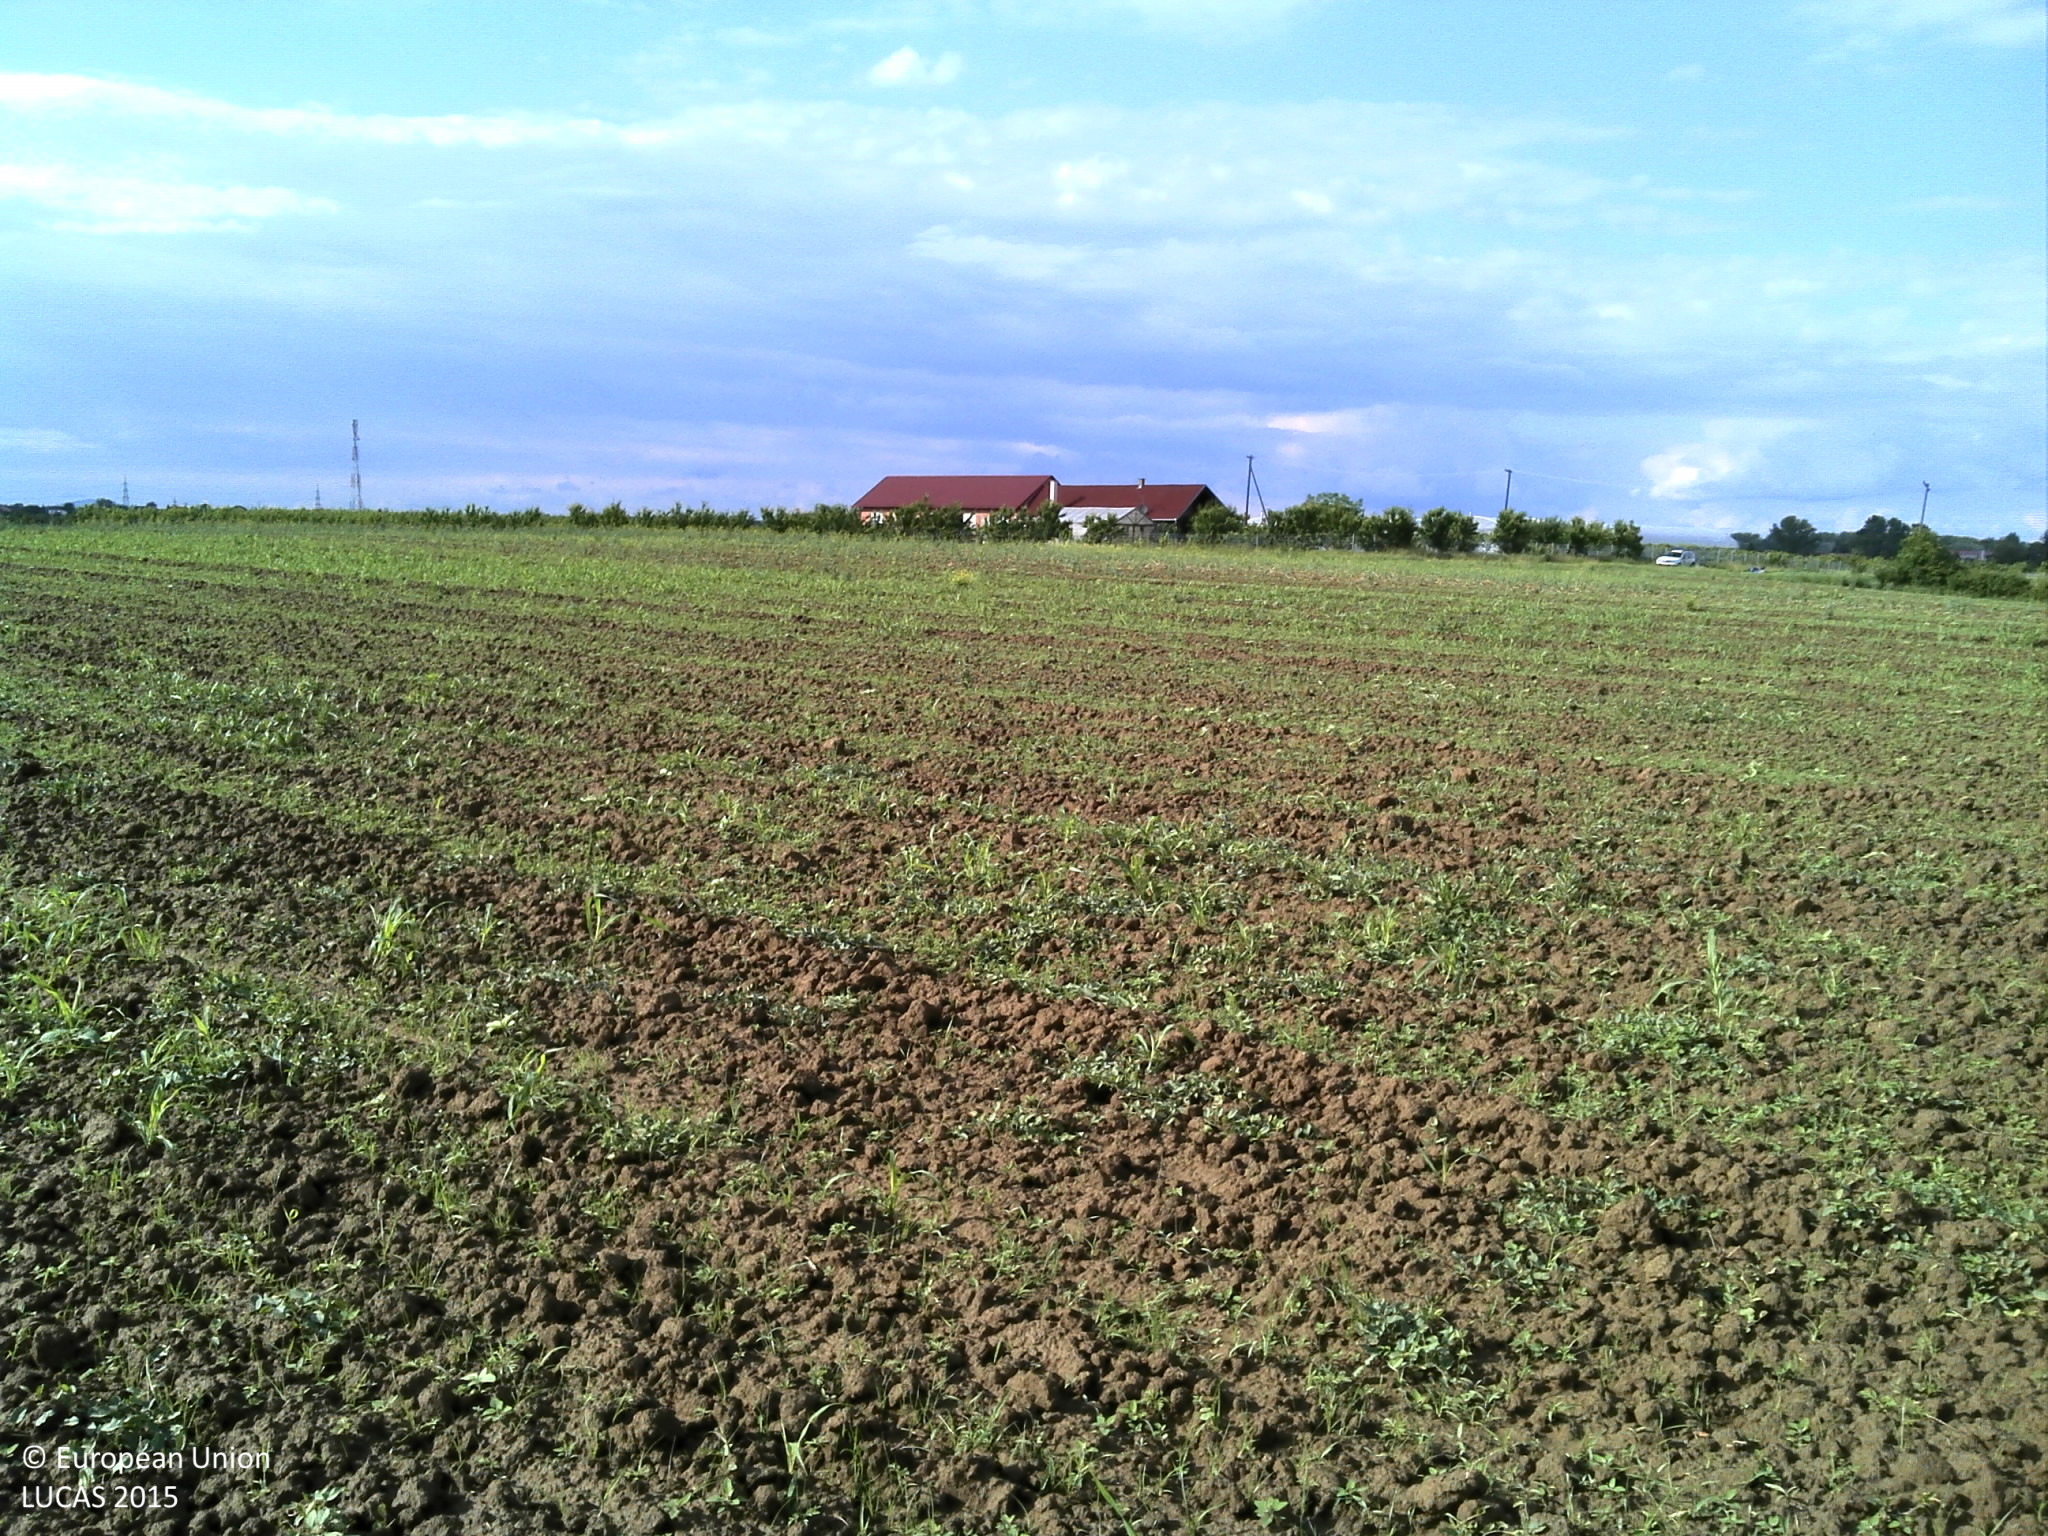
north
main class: Cropland
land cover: Sunflower
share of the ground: < 10 %
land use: Agriculture (excluding fallow land and kitchen gardens)
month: May
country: HR
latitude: 45.5713
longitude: 18.5796
